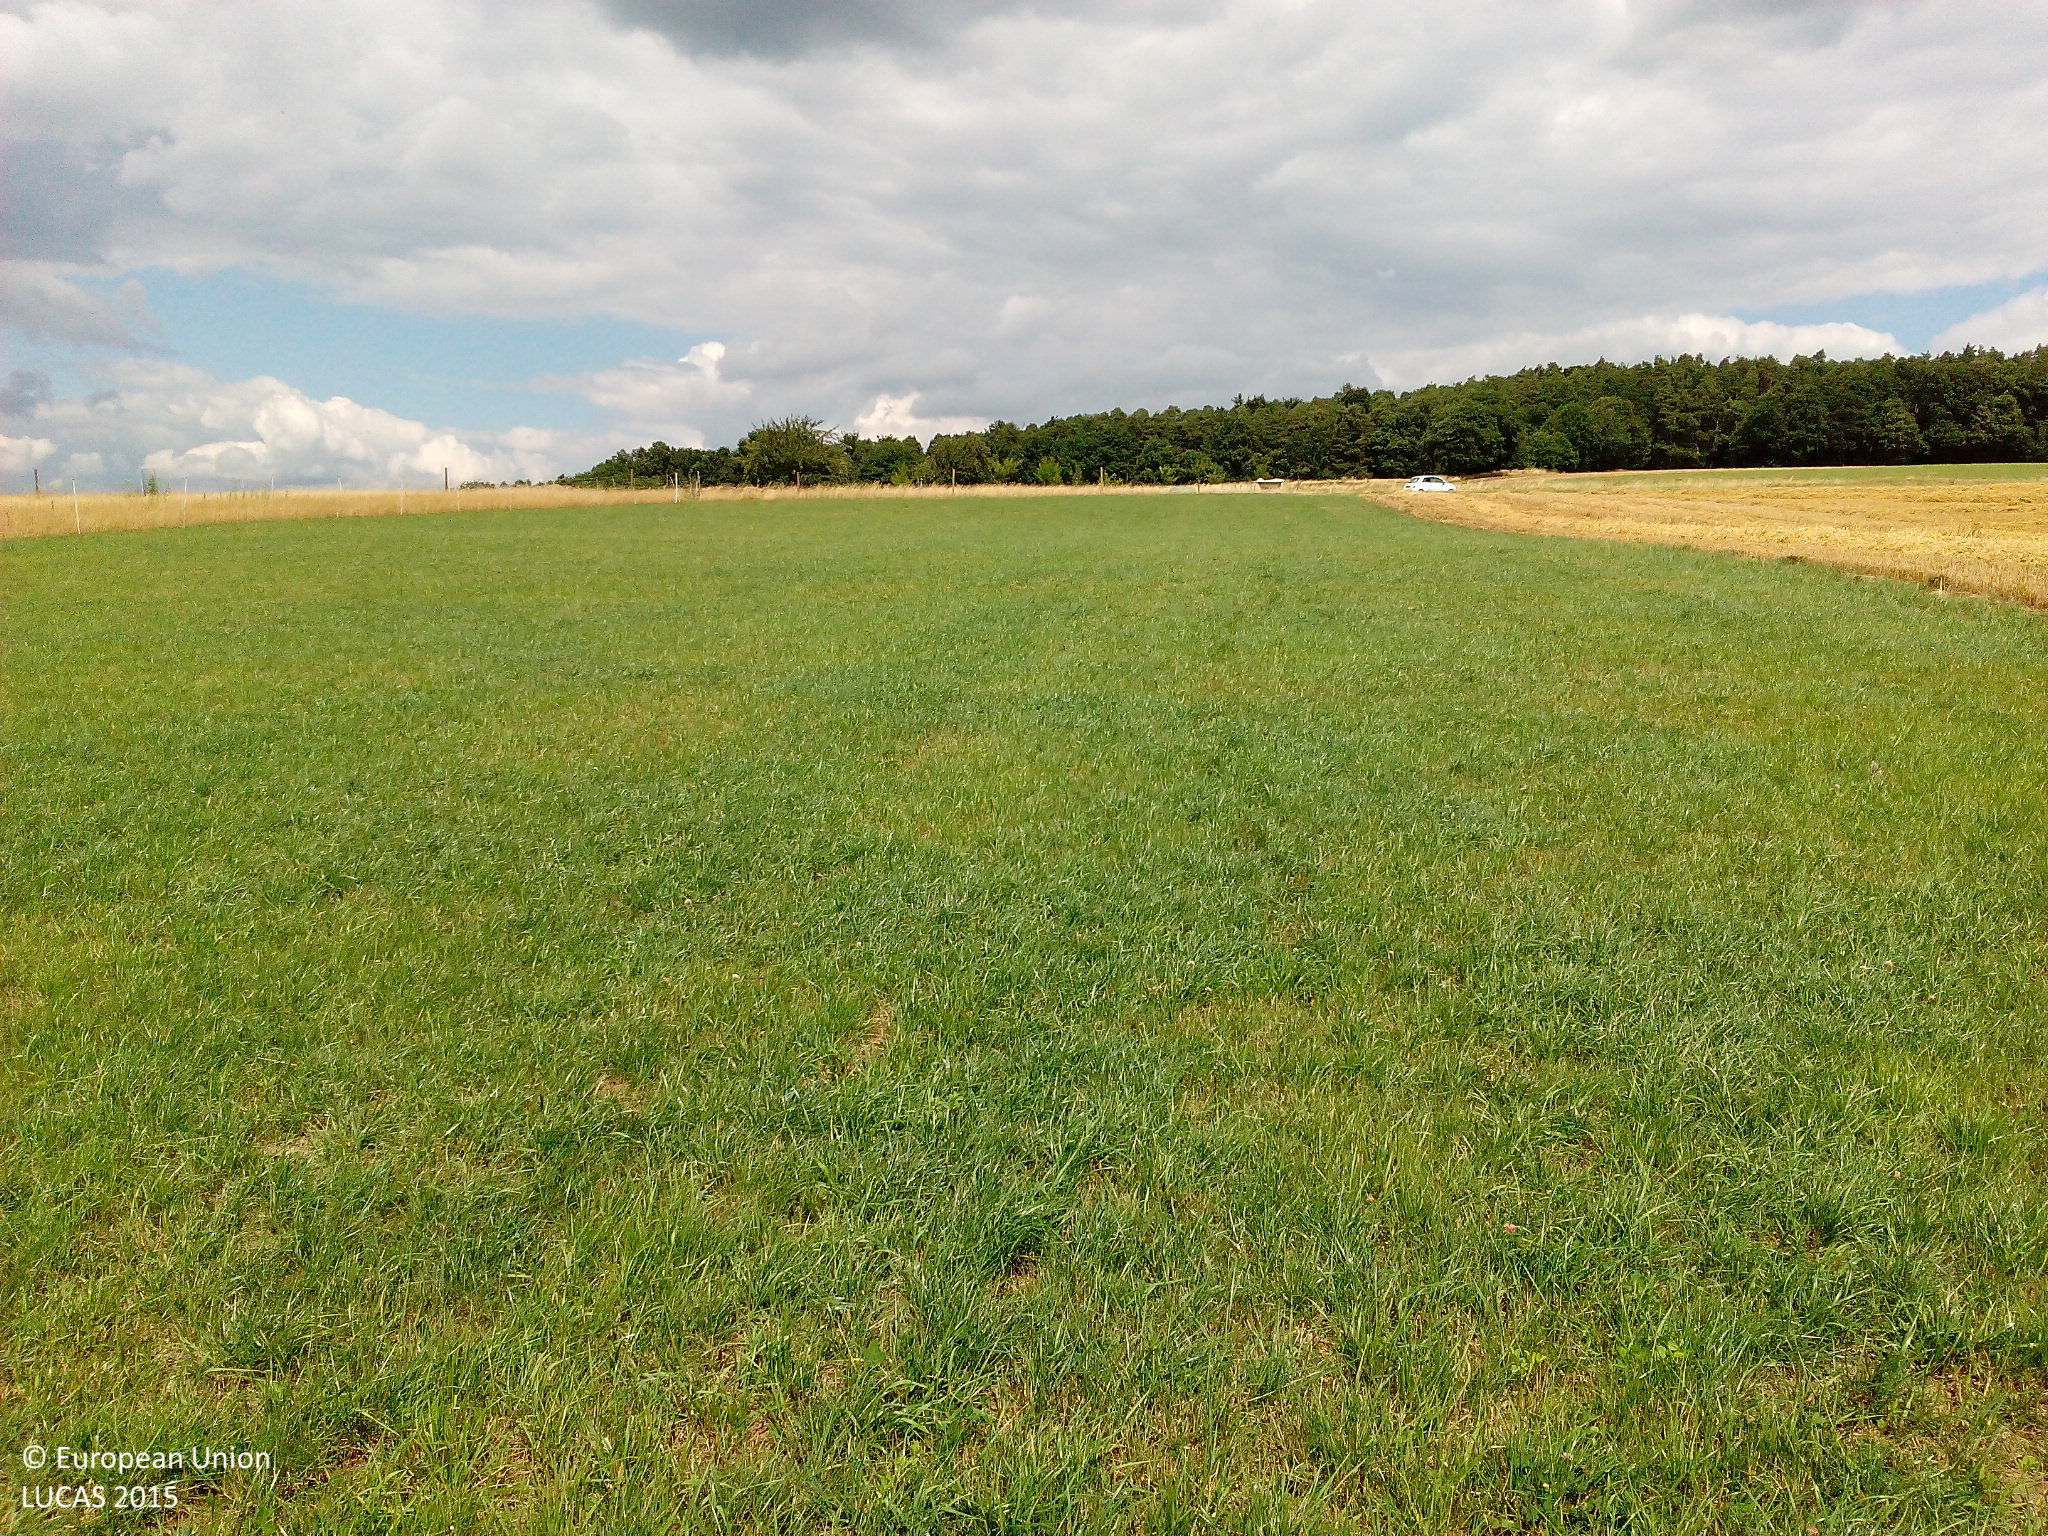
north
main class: Grassland
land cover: Grassland without tree/shrub cover
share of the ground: > 75 %
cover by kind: herbaceous plants 100 %
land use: Agriculture (excluding fallow land and kitchen gardens)
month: July
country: DE
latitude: 50.5791
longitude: 9.5906
